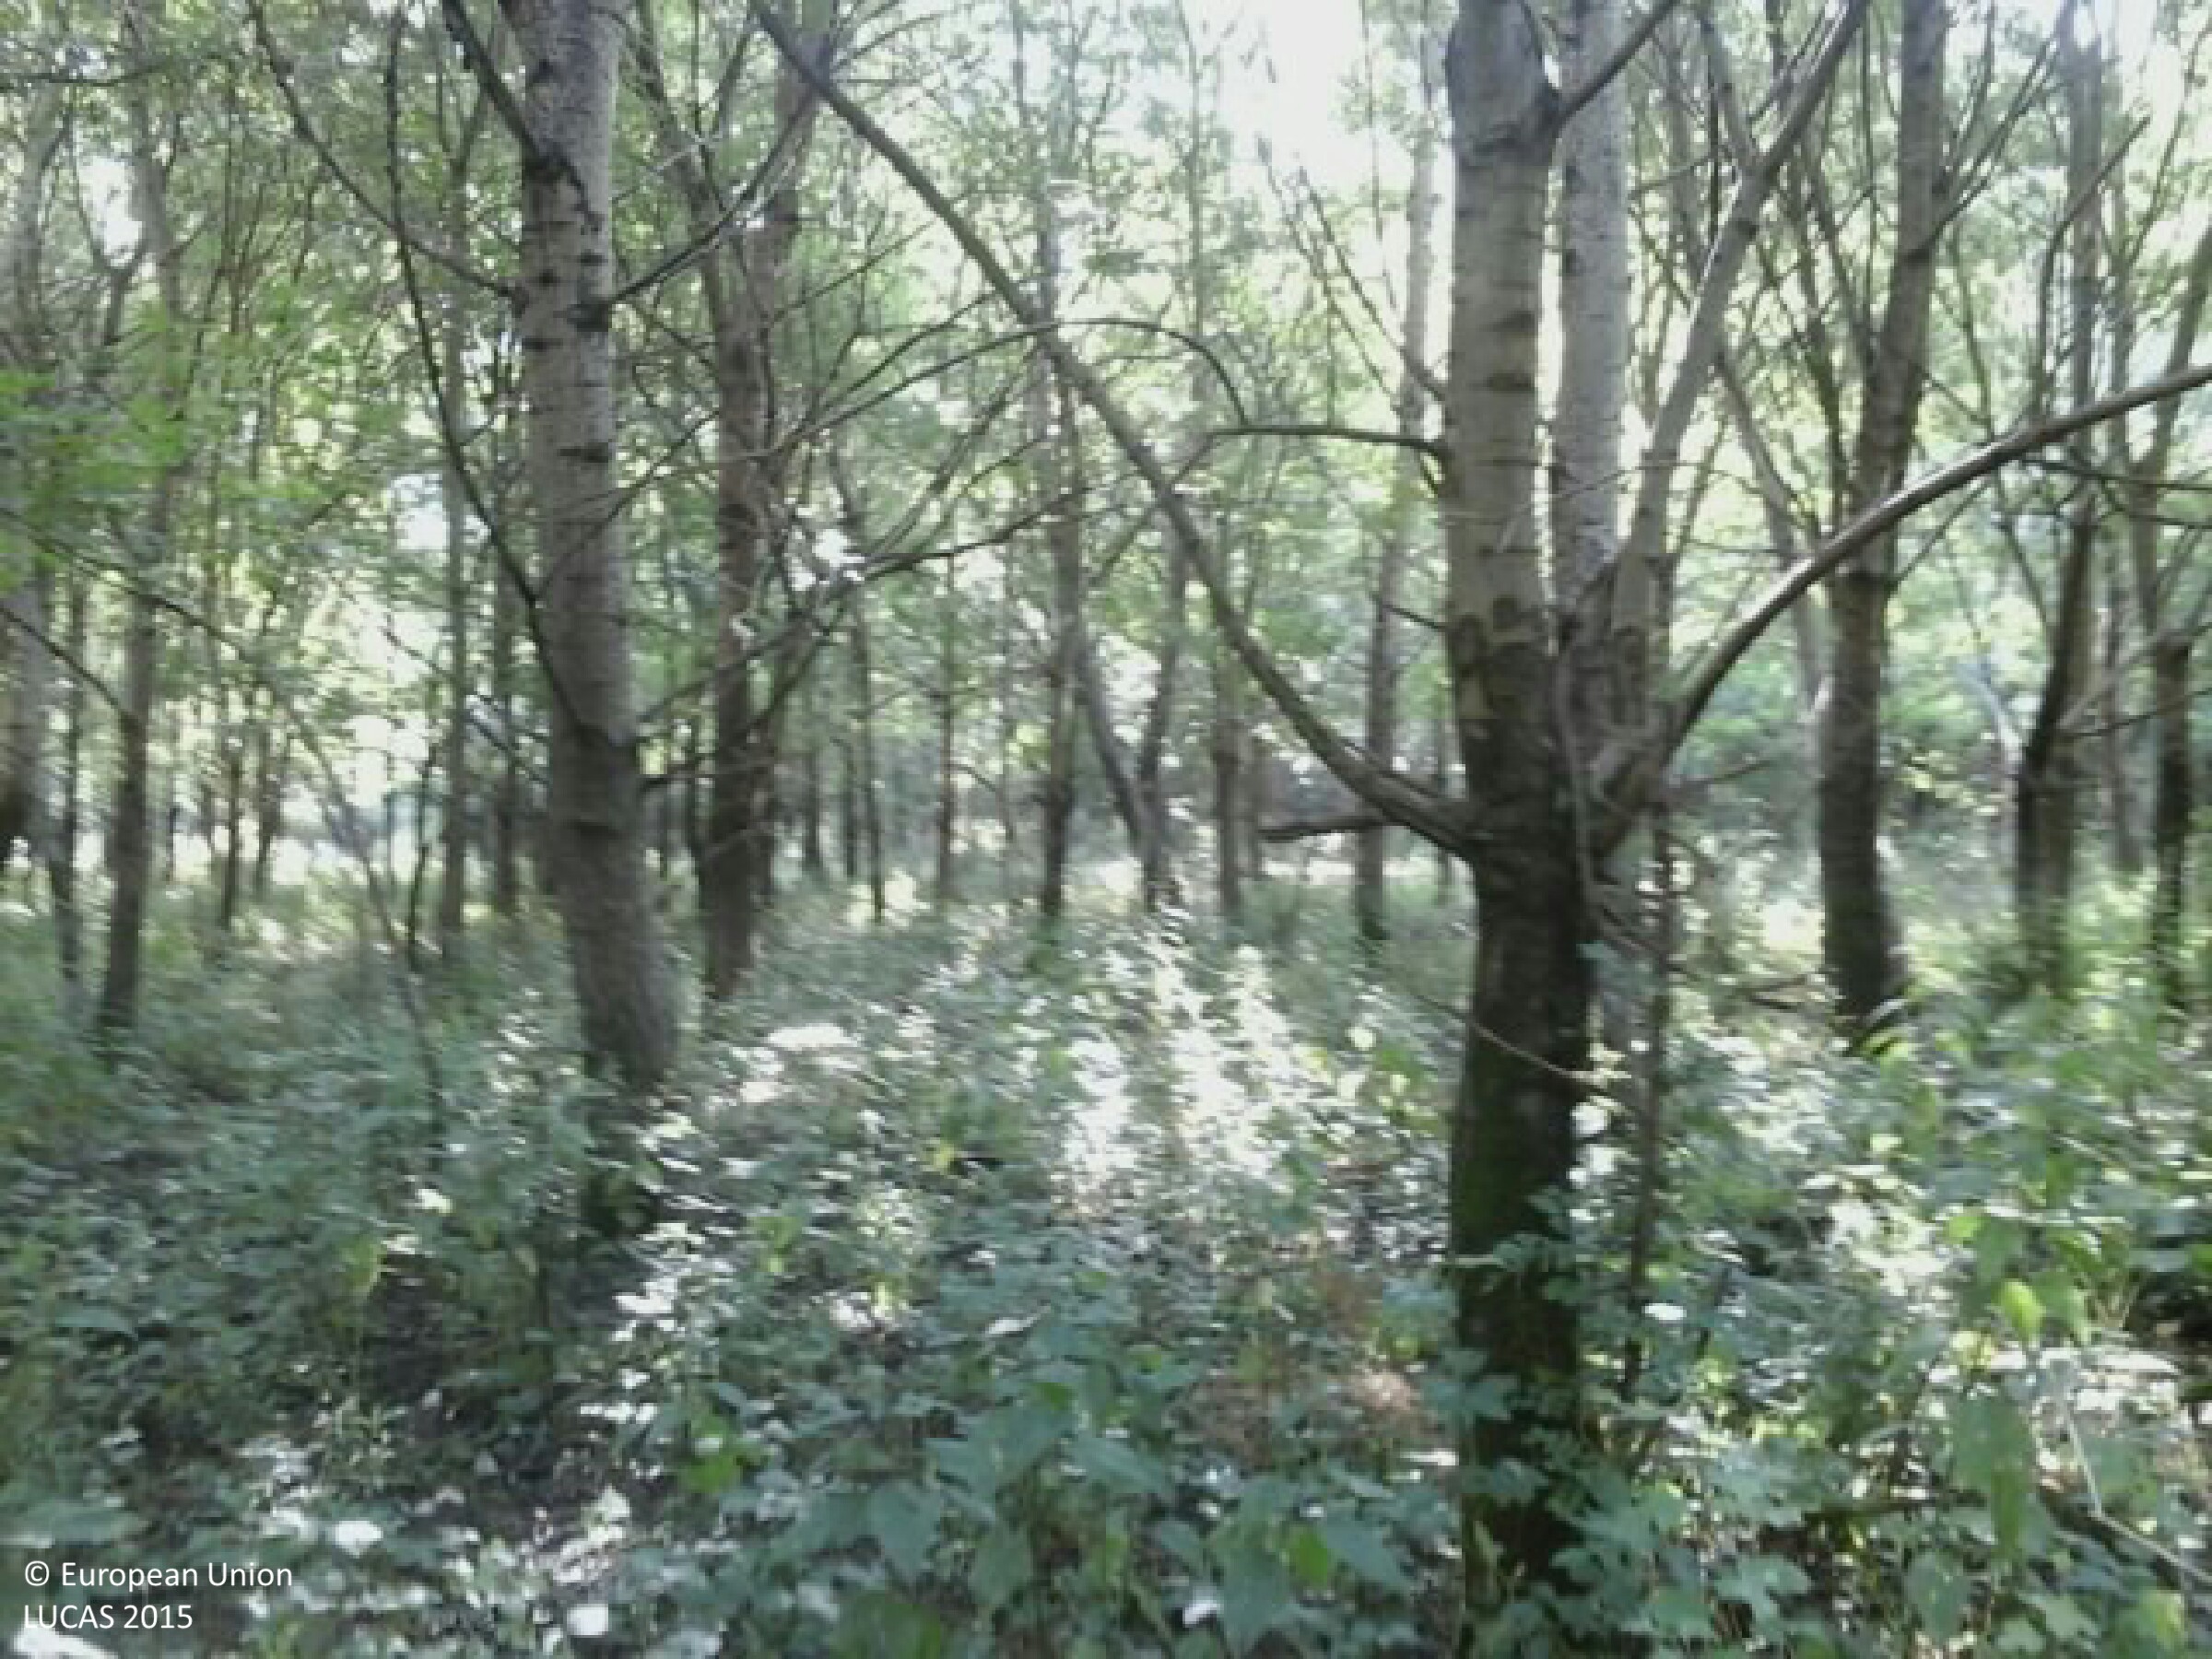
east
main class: Woodland
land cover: Broadleaved woodland
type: mesophytic deciduous forest
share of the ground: > 75 %
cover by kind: broadleaved forest trees 80 %, shrubs 10 %, herbaceous plants 10 %
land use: Forestry
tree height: > 5 m
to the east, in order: Broadleaved woodland; Tracks; Shruby margins; Broadleaved woodland; Shruby margins; Tracks; Shruby margins; Broadleaved woodland
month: July
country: HU
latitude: 46.3052
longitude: 18.9062
